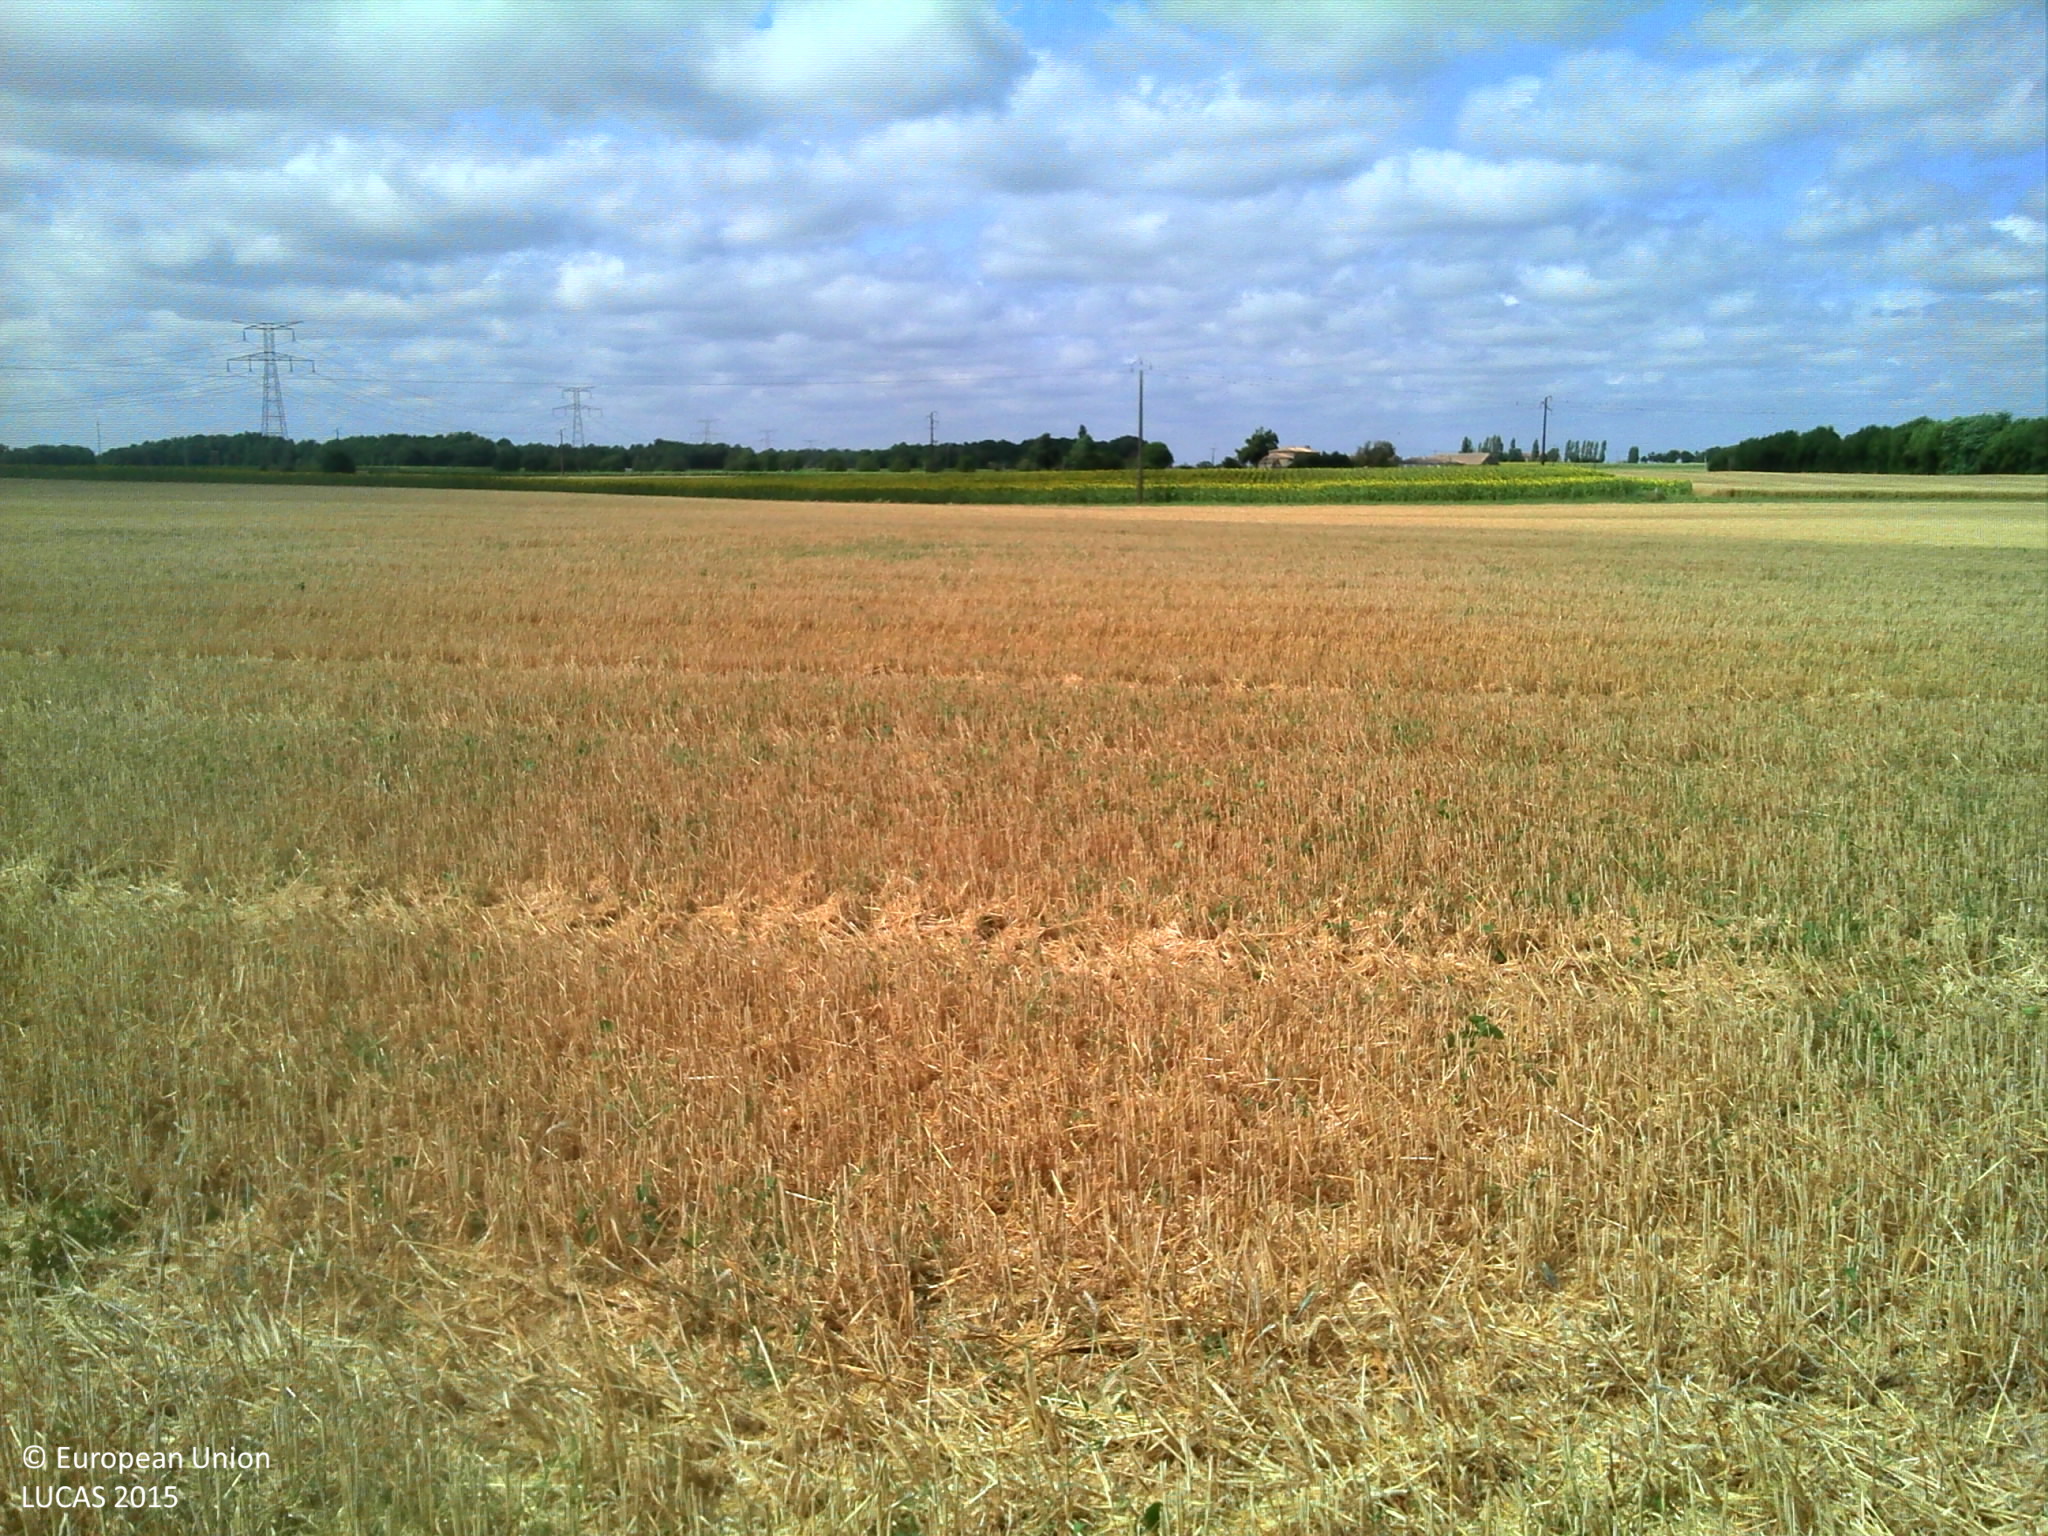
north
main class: Cropland
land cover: Durum wheat
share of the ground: > 75 %
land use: Agriculture (excluding fallow land and kitchen gardens)
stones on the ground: 10 - 25 %
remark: Harvested field
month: July
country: FR
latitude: 45.4955
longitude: -0.6054
